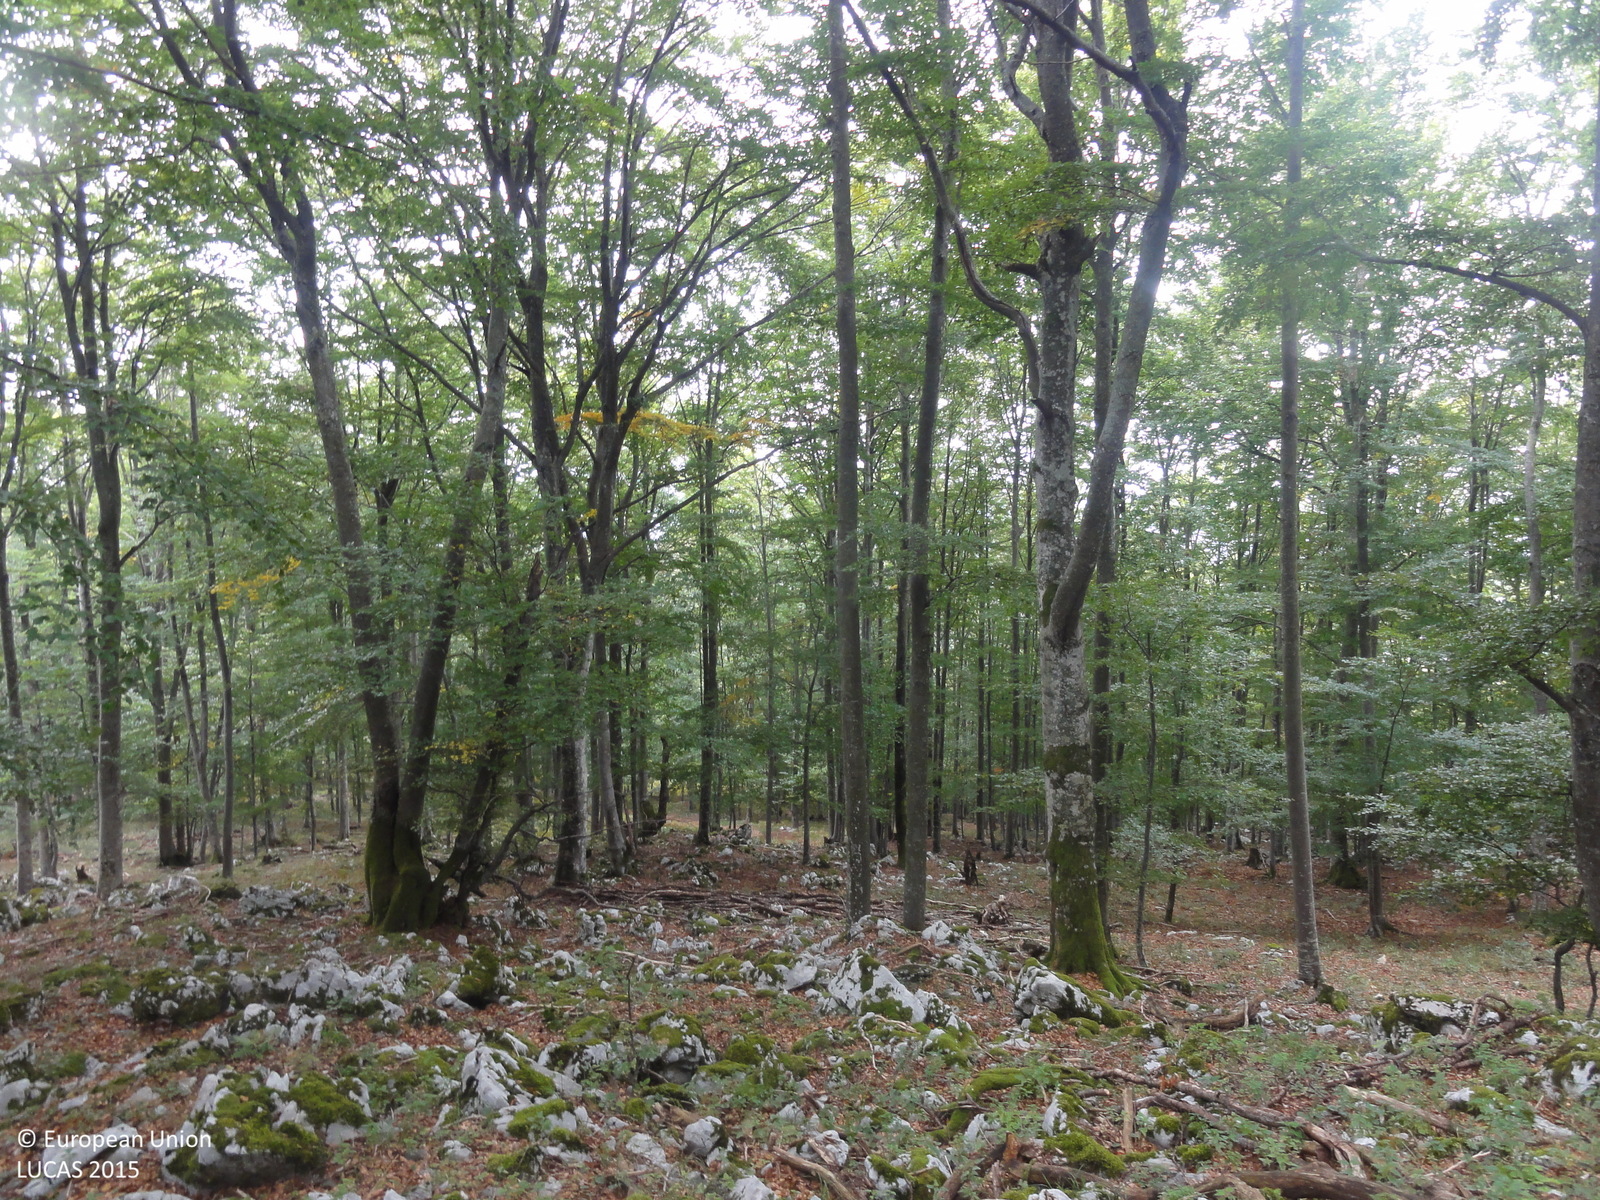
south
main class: Woodland
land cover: Broadleaved woodland
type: mountainous beech forest
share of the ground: > 75 %
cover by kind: broadleaved forest trees 95 %, consolidated bare surface 5 %
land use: Forestry
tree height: > 5 m
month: September
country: SI
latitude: 45.6034
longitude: 14.9833
